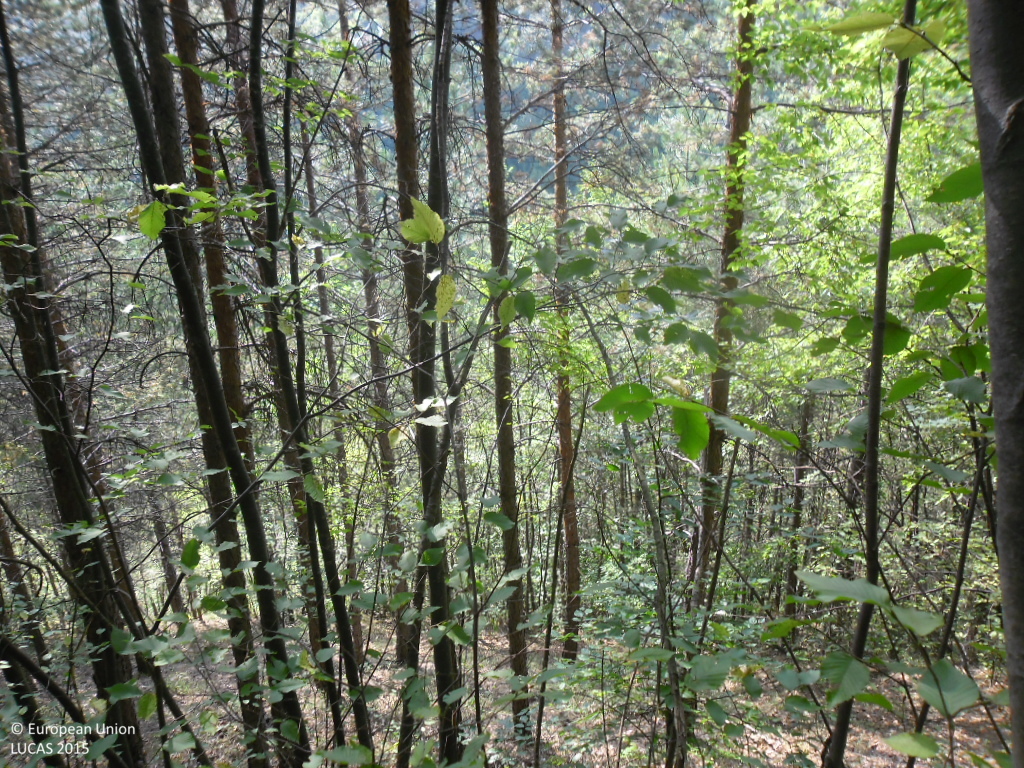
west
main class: Woodland
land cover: Pine dominated mixed woodland
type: hemiboreal forest and nemoral coniferous forest and mixed broadleaved-coniferous forest
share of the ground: > 75 %
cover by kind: coniferous forest trees 75 %, broadleaved forest trees 25 %
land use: Forestry
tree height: > 5 m
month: September
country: BG
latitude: 41.8080
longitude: 23.0329
